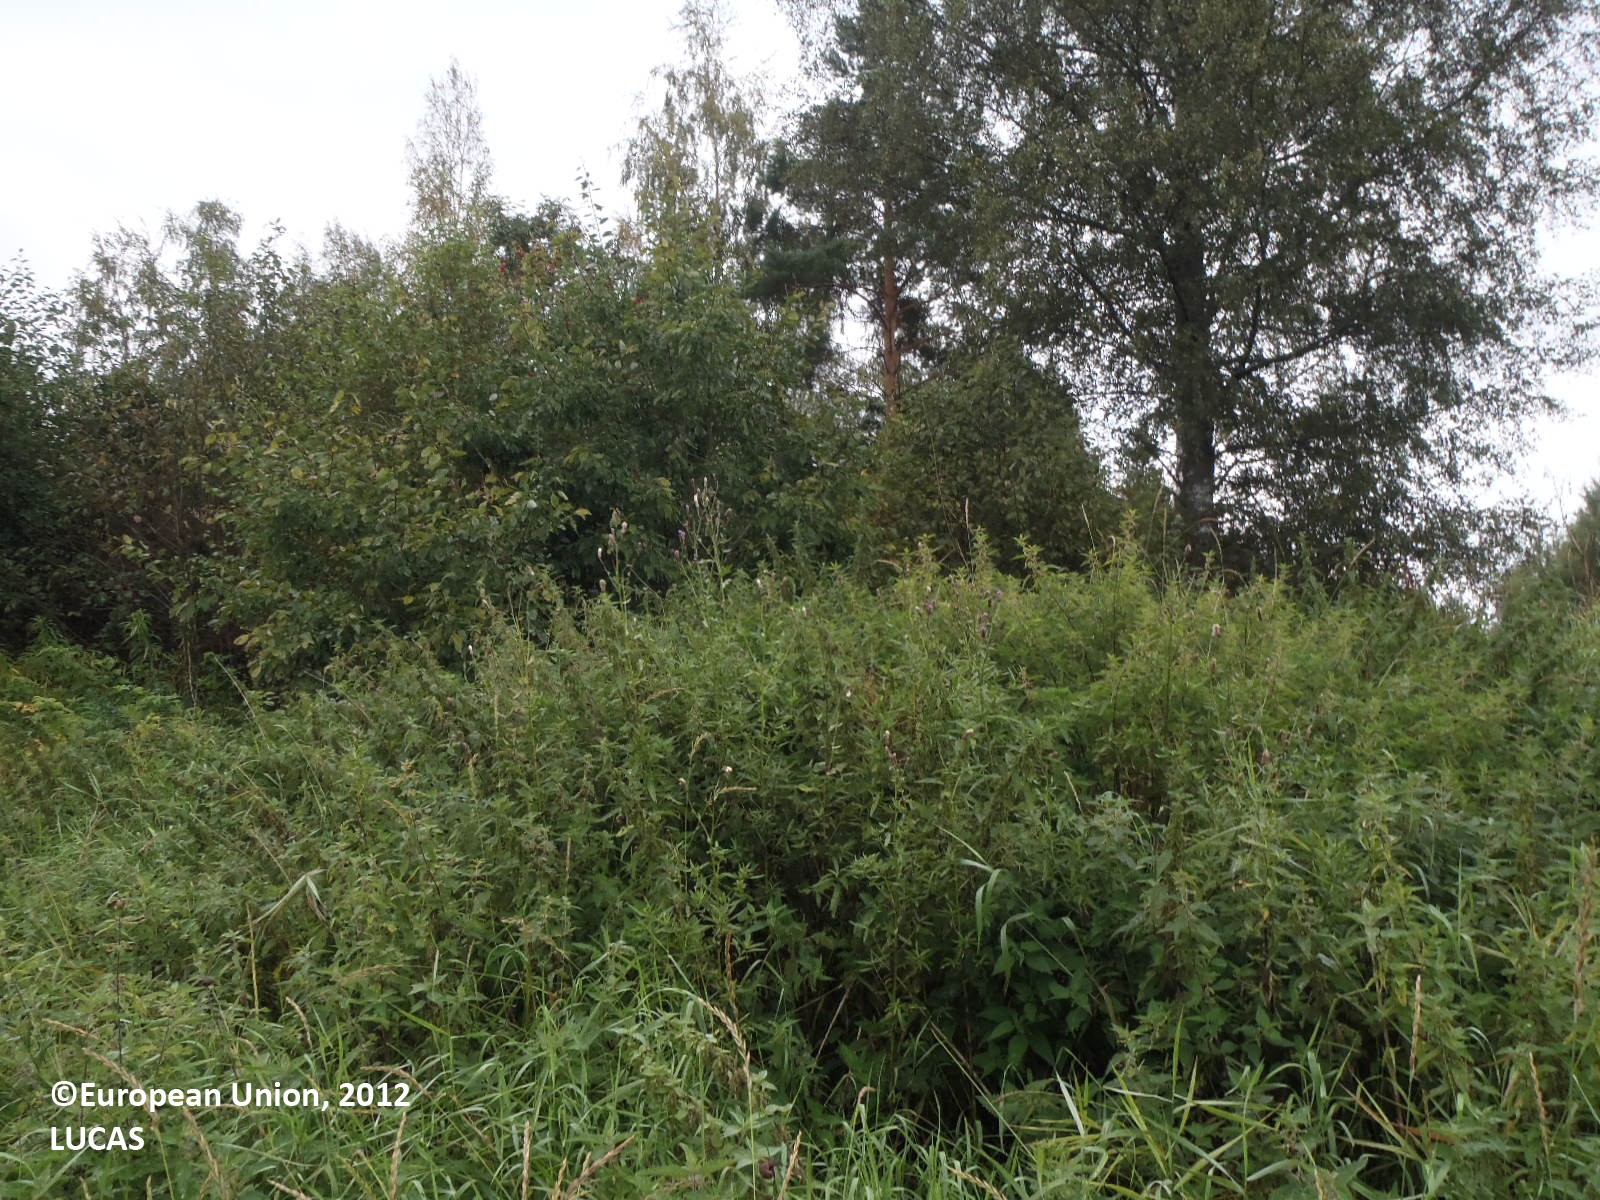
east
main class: Grassland
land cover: Grassland without tree/shrub cover
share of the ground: > 75 %
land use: Commerce, finance, business
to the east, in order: Grassland without tree/shrub cover; Broadleaved woodland; Ditches and canals; Grass margins; Temporary grasslands
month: August
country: FI
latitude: 60.8738
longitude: 22.3877
